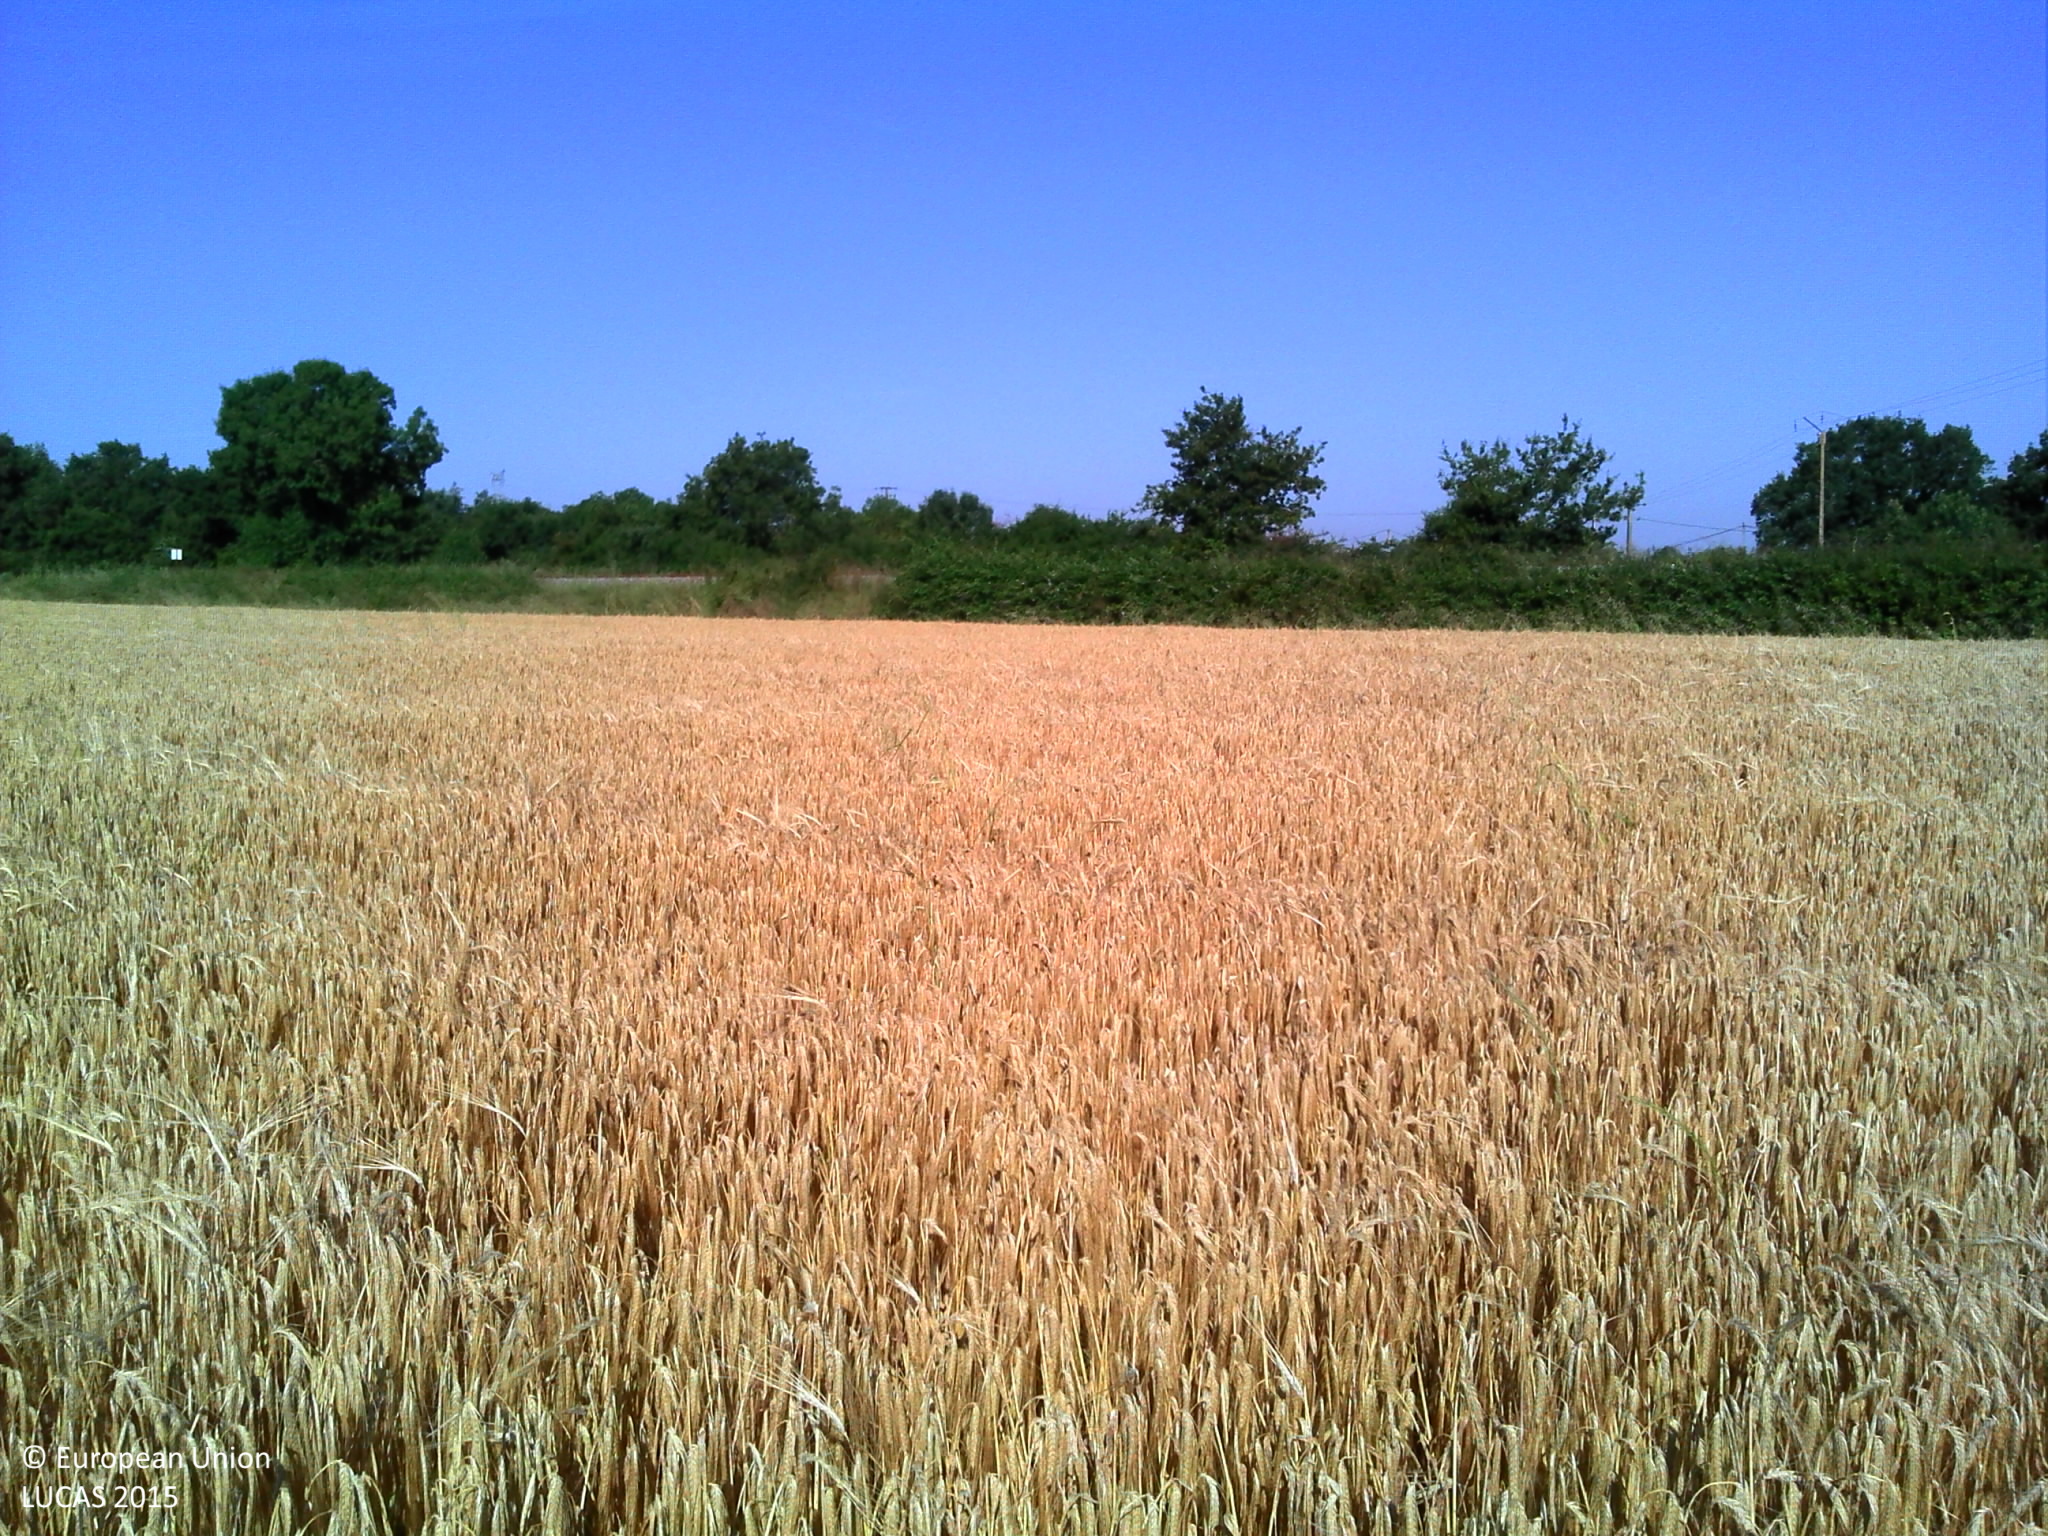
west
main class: Cropland
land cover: Barley
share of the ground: > 75 %
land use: Agriculture (excluding fallow land and kitchen gardens)
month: June
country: FR
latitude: 46.9653
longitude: -1.8335
